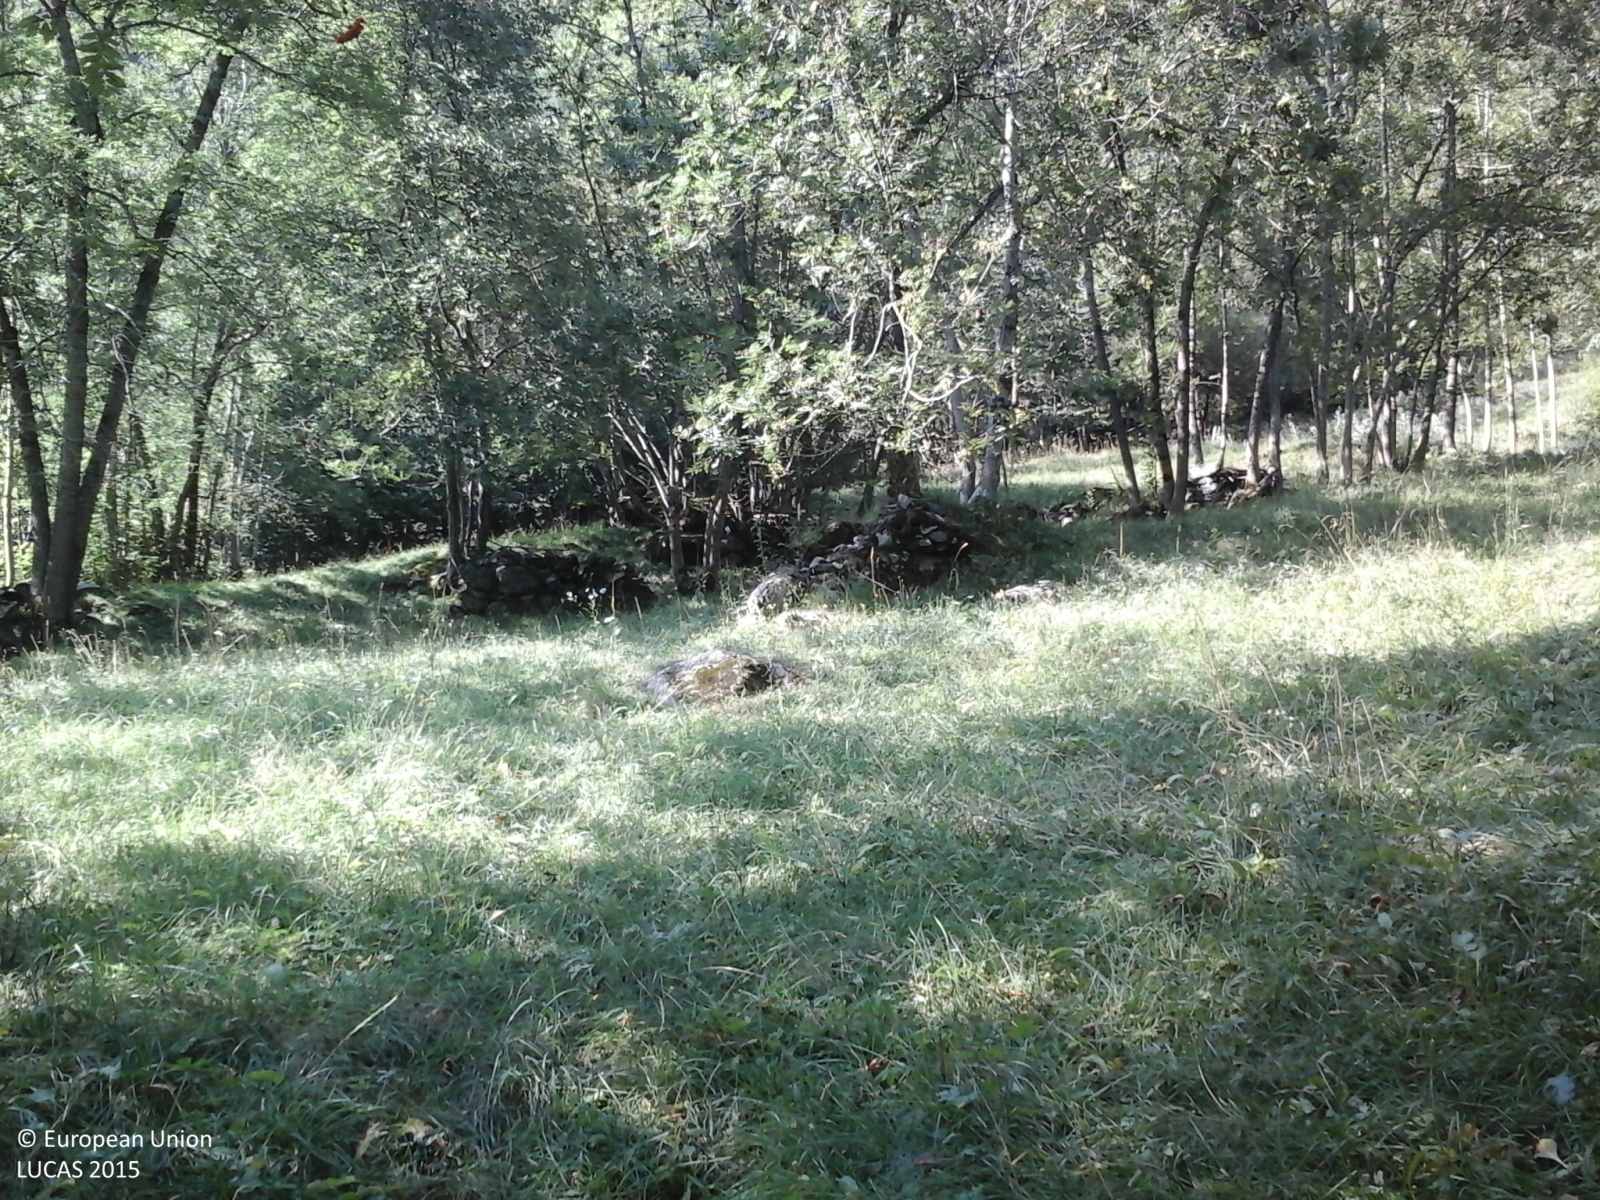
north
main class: Woodland
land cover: Broadleaved woodland
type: thermophilous deciduous forest
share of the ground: > 75 %
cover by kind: broadleaved forest trees 70 %, herbaceous plants 20 %, shrubs 10 %
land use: Forestry
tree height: > 5 m
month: August
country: IT
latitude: 45.6221
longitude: 7.6308
